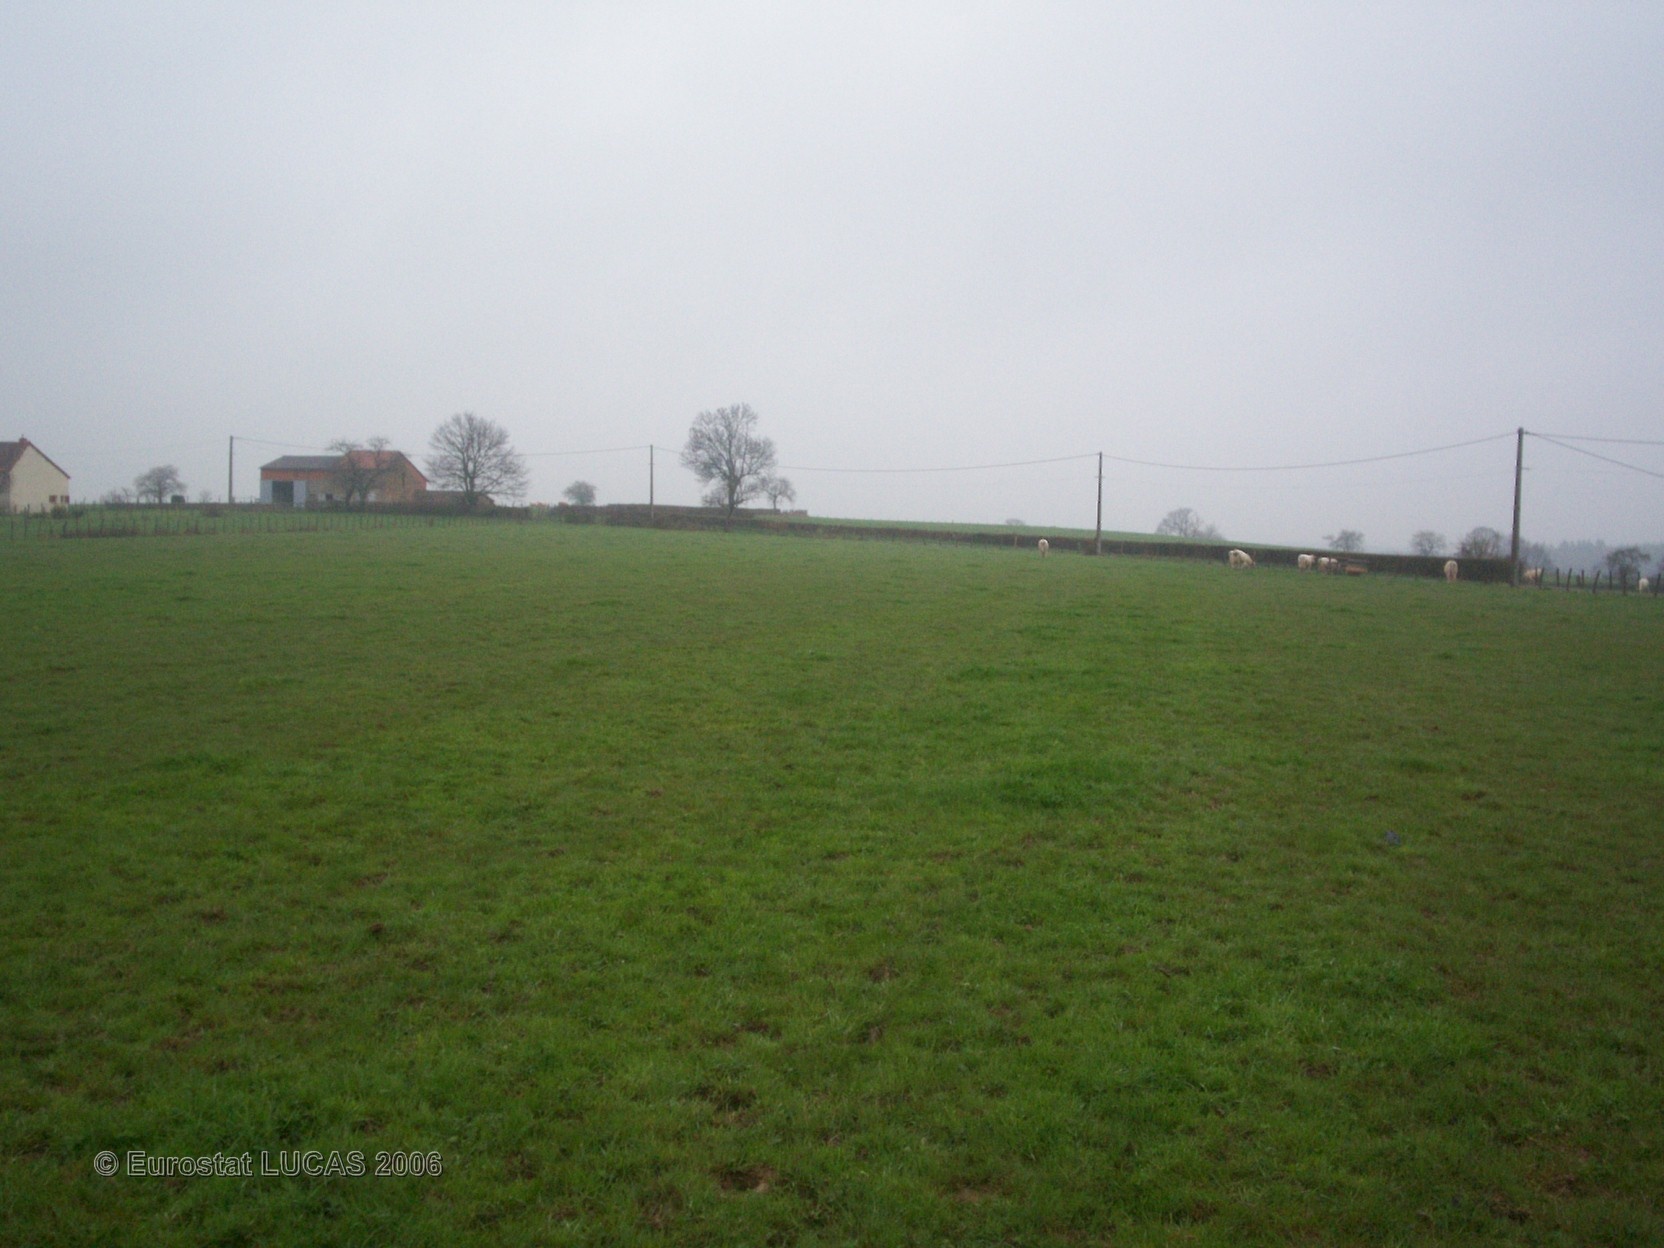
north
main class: Grassland
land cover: Grassland without tree/shrub cover
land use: Agriculture (excluding fallow land and kitchen gardens)
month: April
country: FR
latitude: 46.2770
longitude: 4.0703
